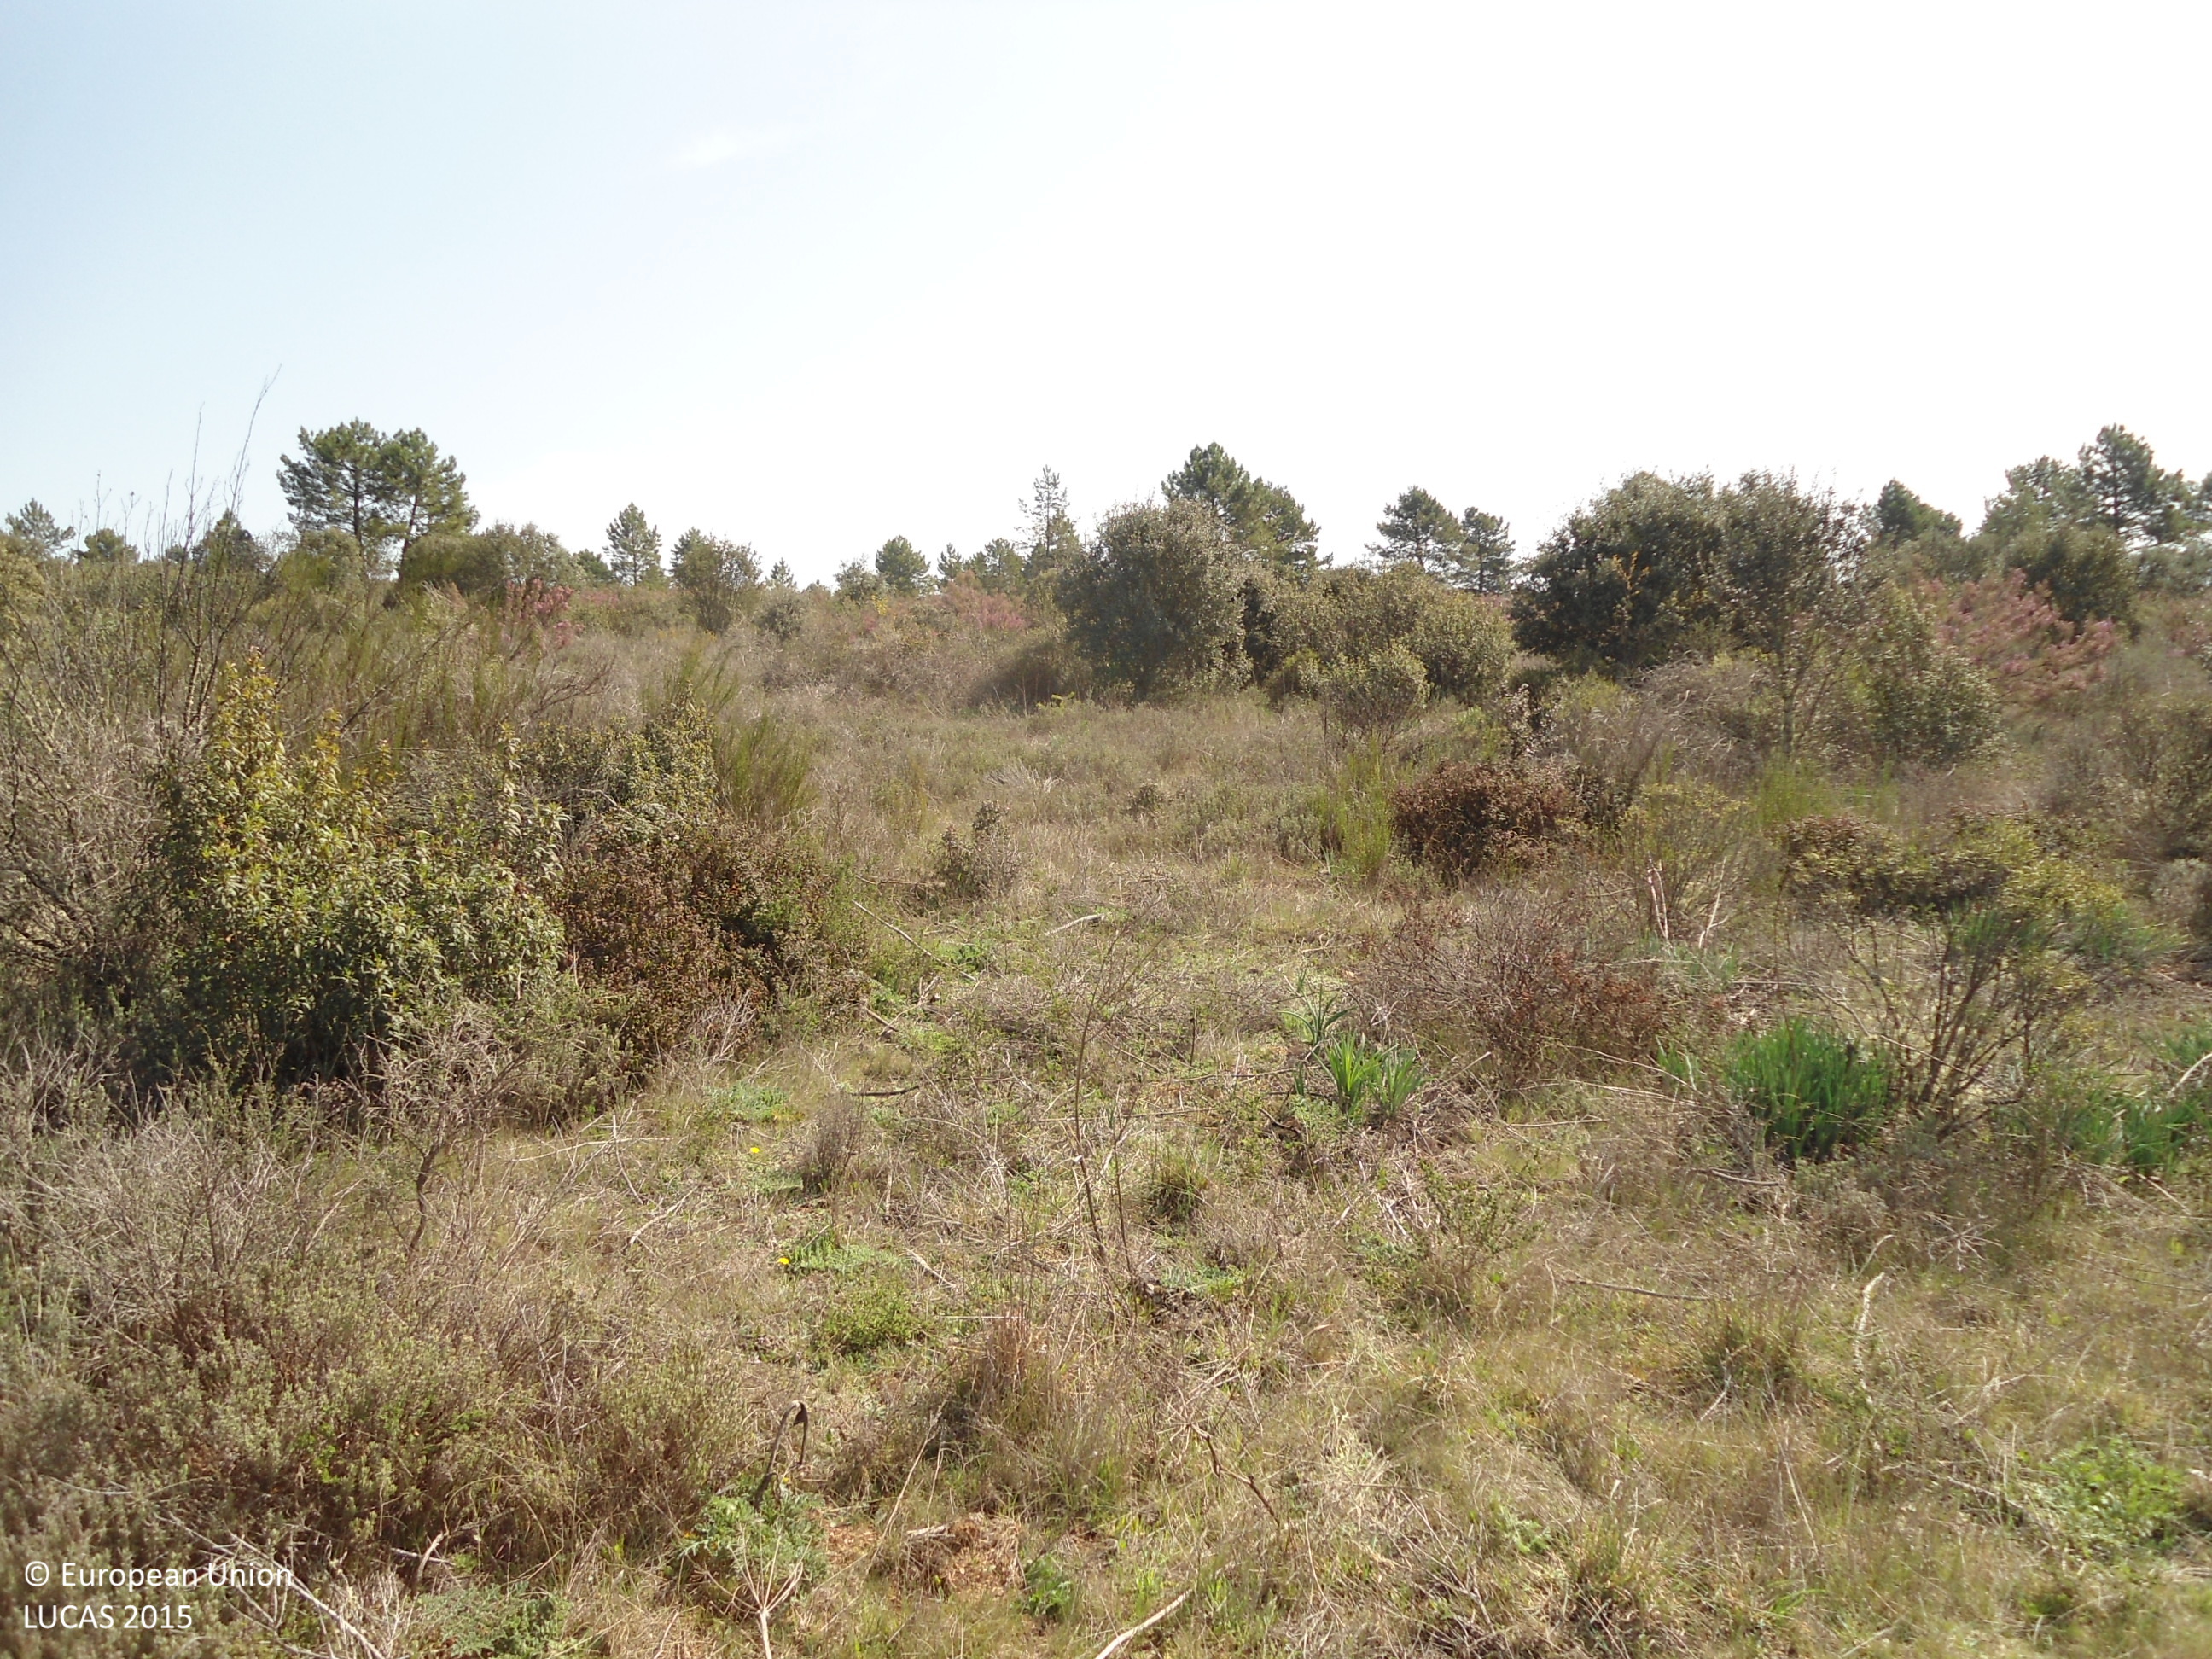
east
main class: Shrubland
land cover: Shrubland without tree cover
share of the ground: > 75 %
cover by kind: shrubs 90 %, herbaceous plants 10 %
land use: Semi-natural and natural areas not in use
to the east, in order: Shrubland without tree cover; Pine dominated coniferous woodland; Shrubland with sparse tree cover; Tracks; Pine dominated coniferous woodland; Shrubland with sparse tree cover; Pine dominated coniferous woodland
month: April
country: ES
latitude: 41.7013
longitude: -6.4595
